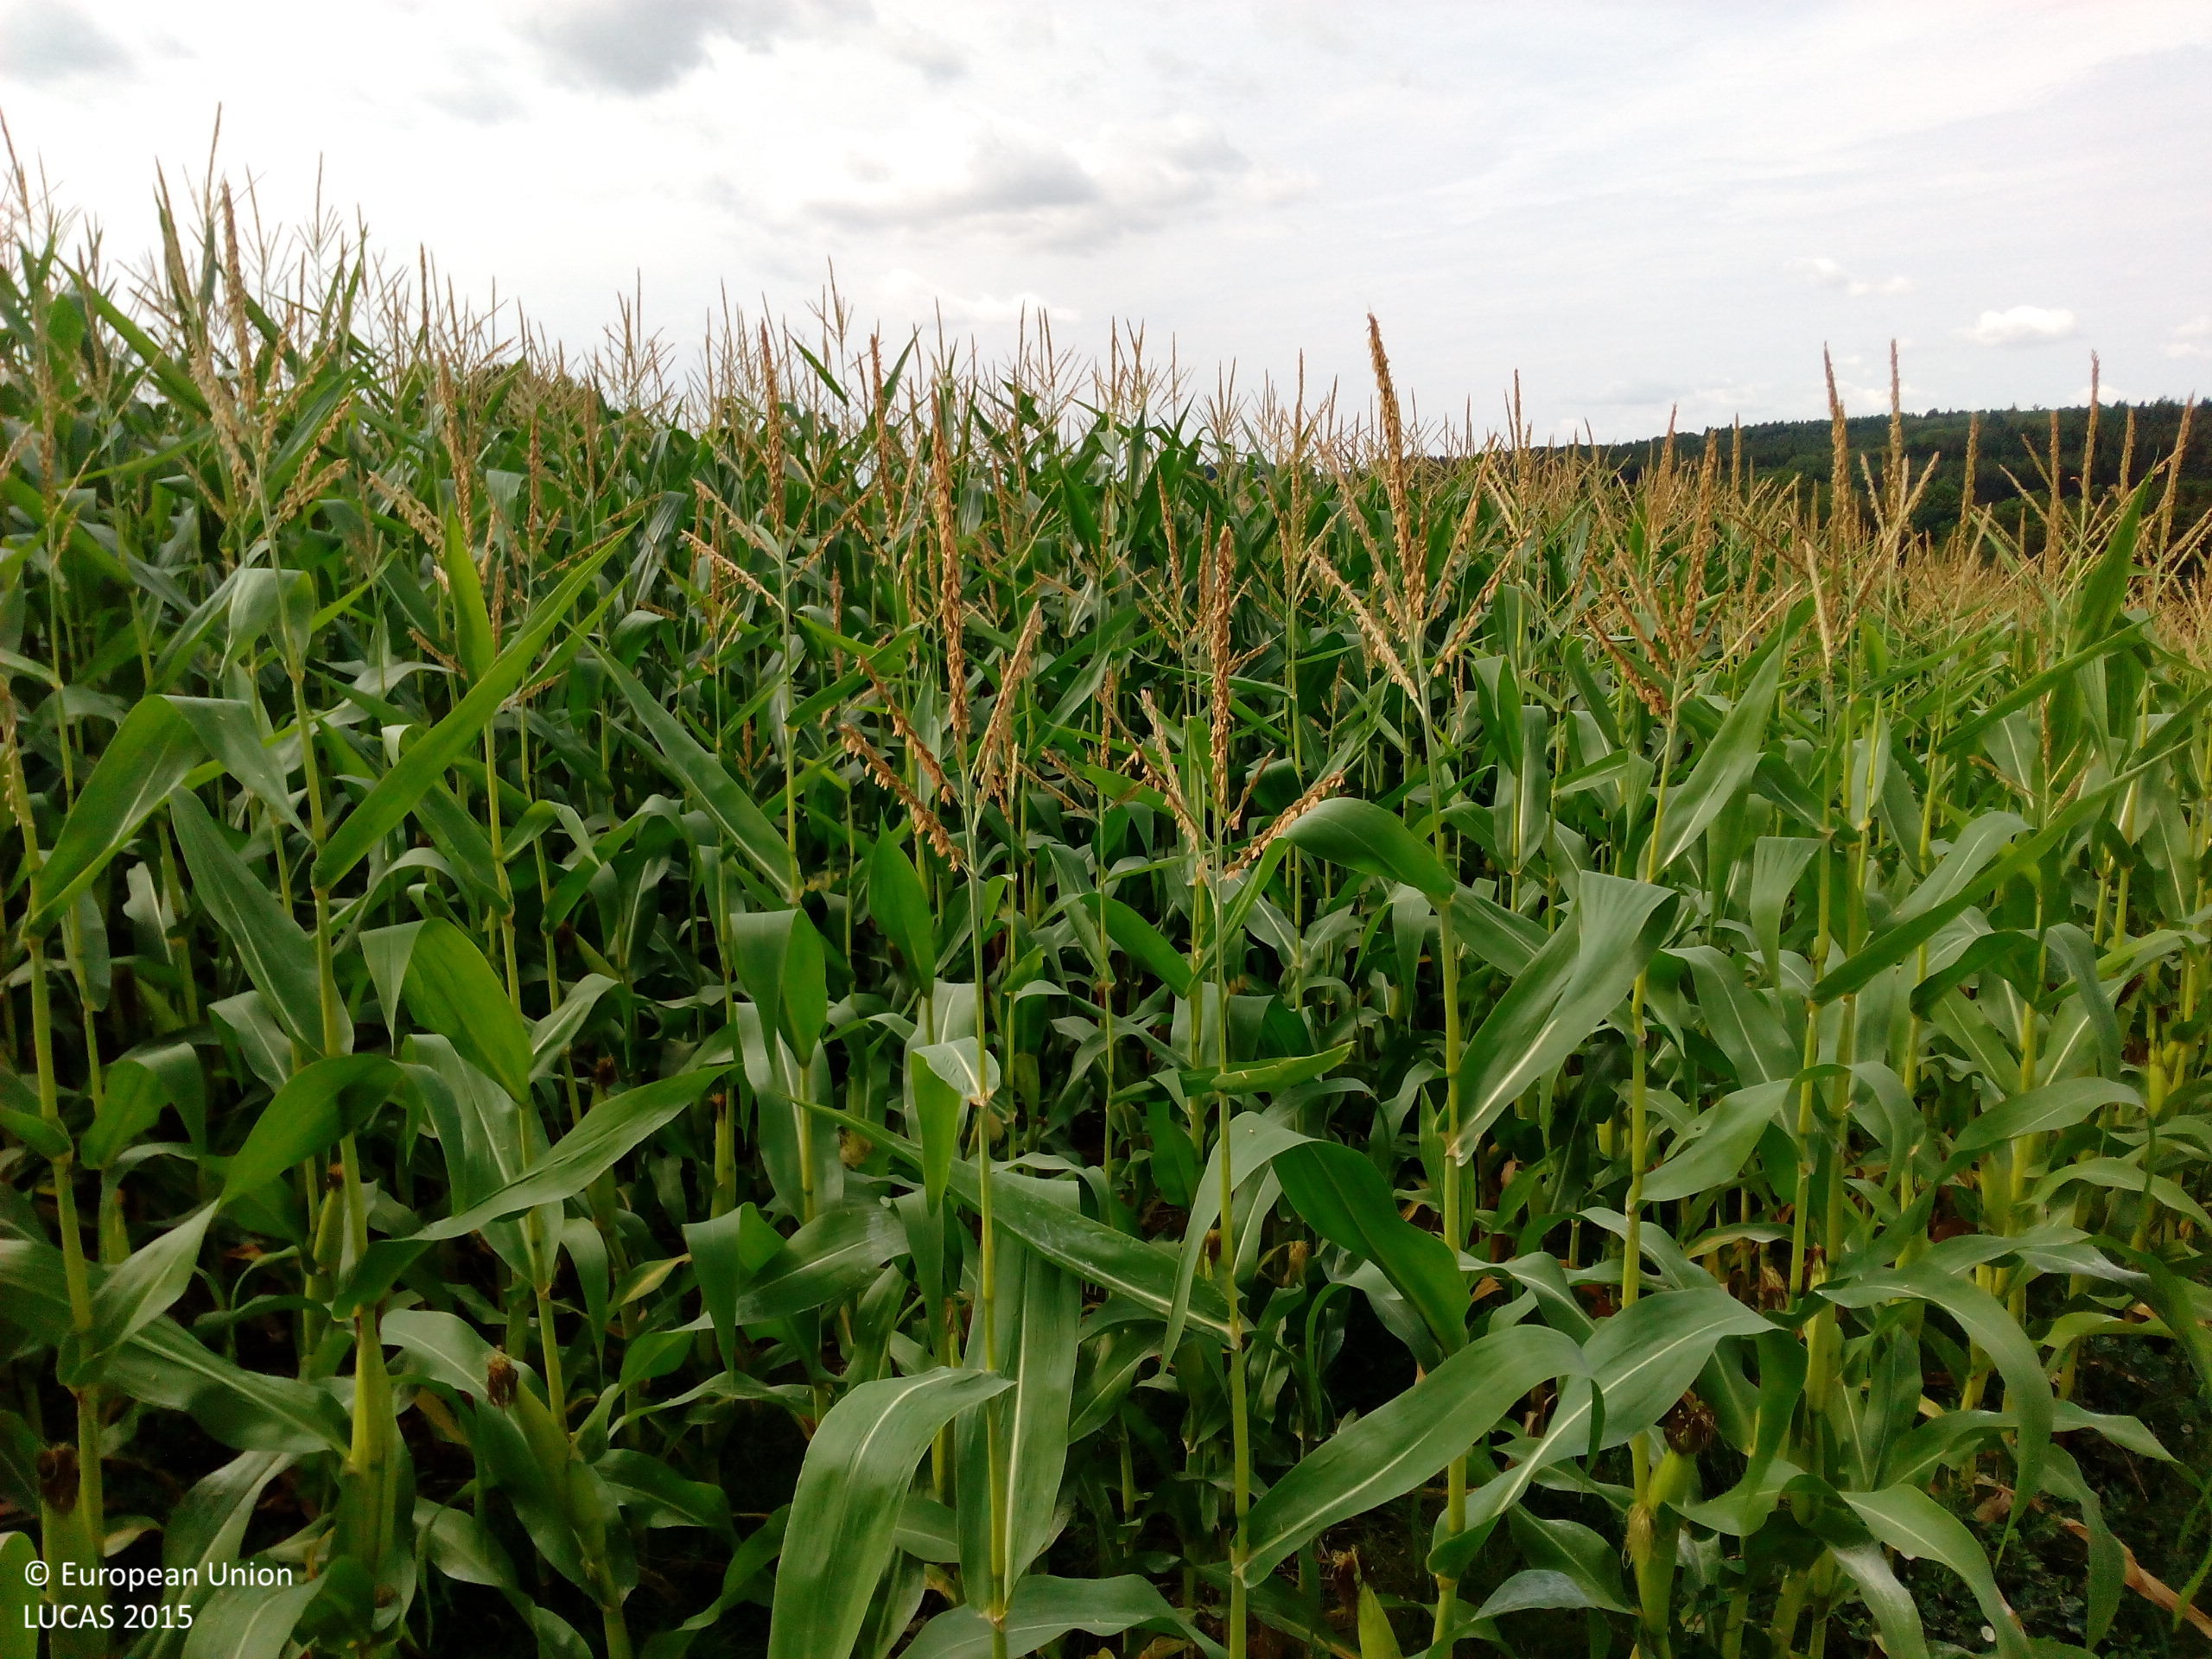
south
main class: Cropland
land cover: Maize
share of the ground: > 75 %
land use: Agriculture (excluding fallow land and kitchen gardens)
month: July
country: DE
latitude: 48.5338
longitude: 13.3174
